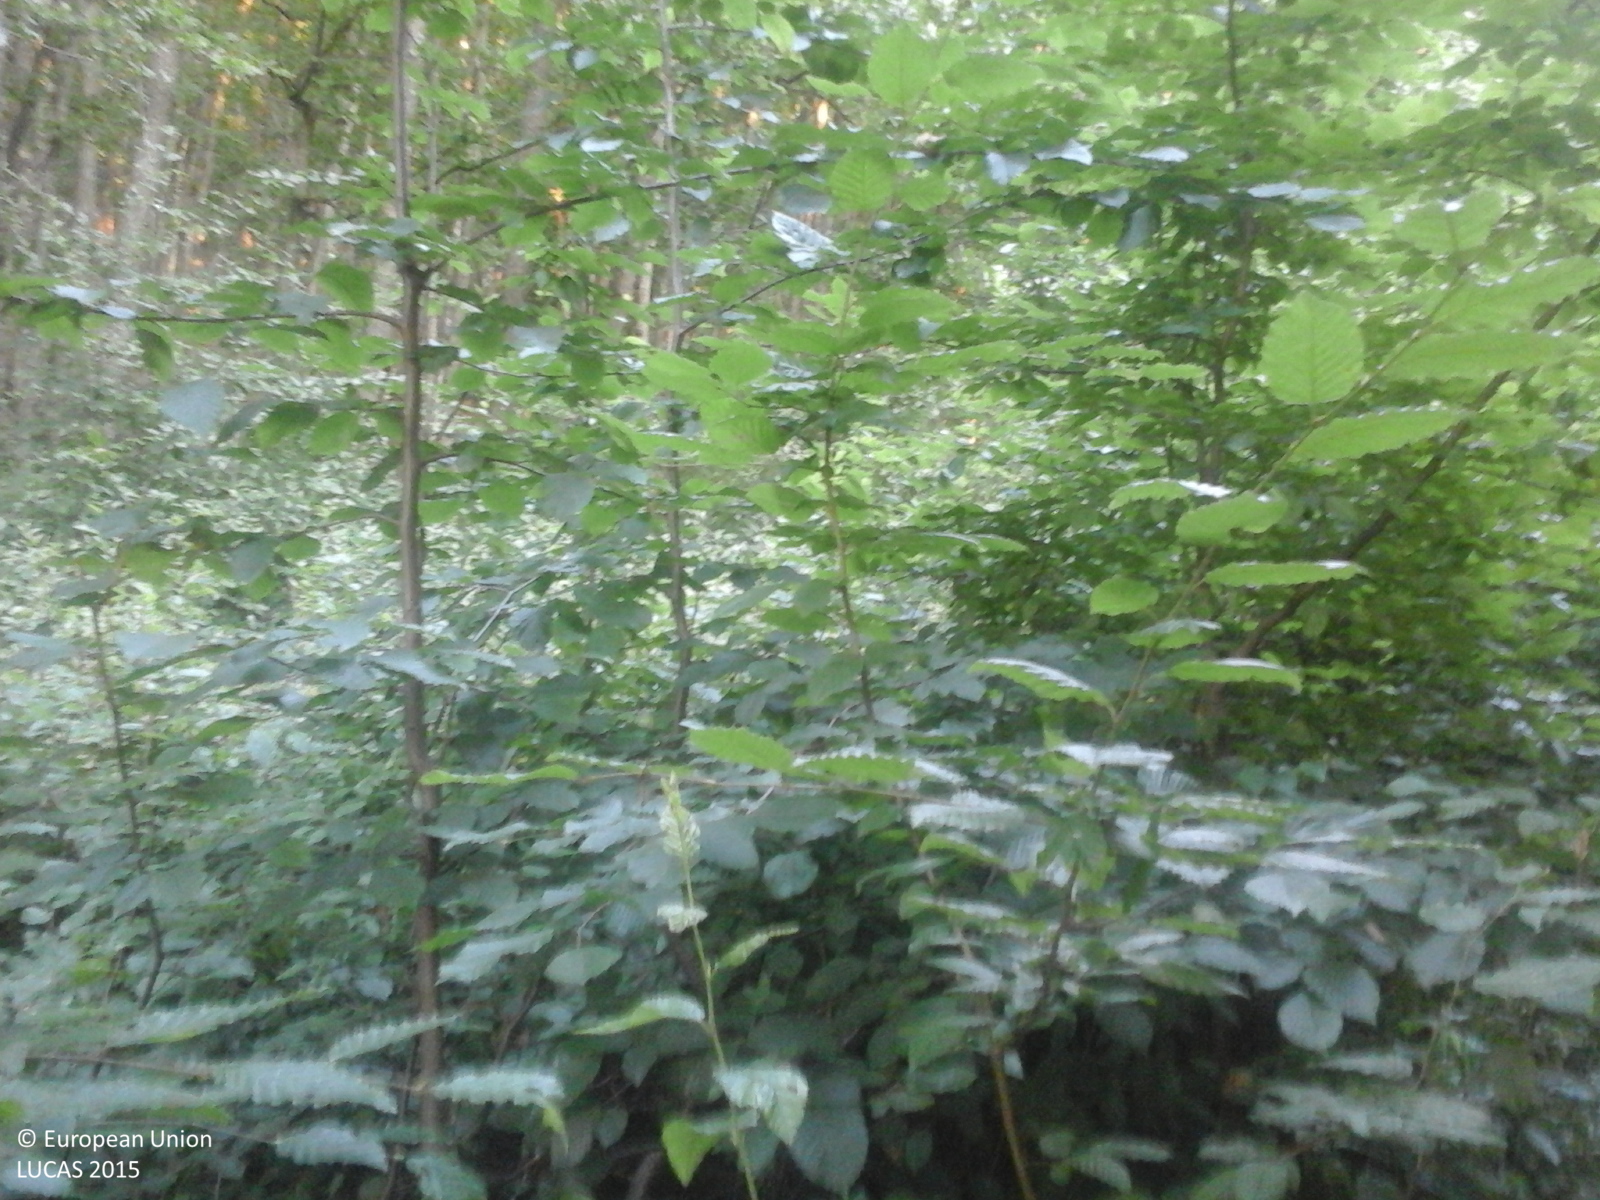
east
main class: Woodland
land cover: Broadleaved woodland
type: beech forest
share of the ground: > 75 %
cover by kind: broadleaved forest trees 100 %
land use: Forestry
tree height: > 5 m
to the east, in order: Broadleaved woodland; Ditches and canals; Broadleaved woodland; Tracks; Broadleaved woodland; Tracks; Spontaneously vegetated surfaces; Fences; Other fruit trees and berries
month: July
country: RO
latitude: 44.9632
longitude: 24.5671
